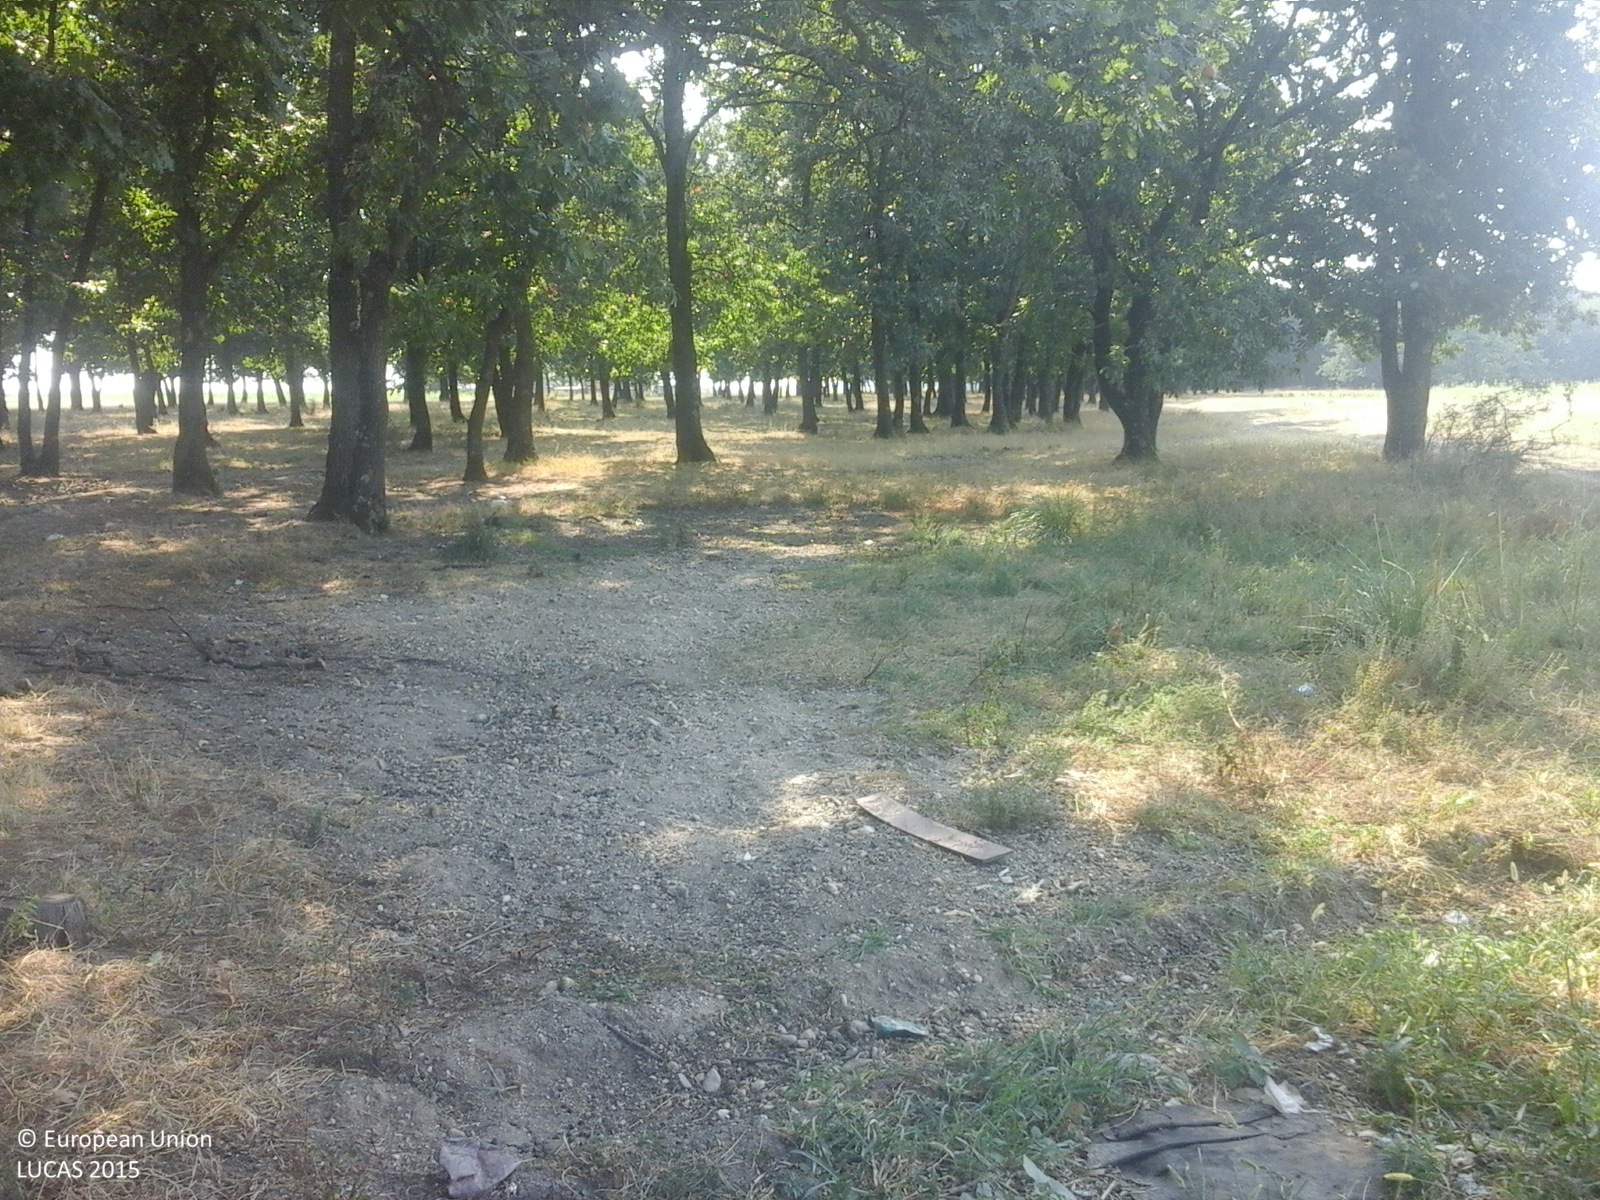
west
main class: Woodland
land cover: Broadleaved woodland
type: acidophilous oak and oak-birch forest
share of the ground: > 75 %
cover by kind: broadleaved forest trees 100 %
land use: Forestry
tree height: > 5 m
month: August
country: RO
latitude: 44.2743
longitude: 23.7240
